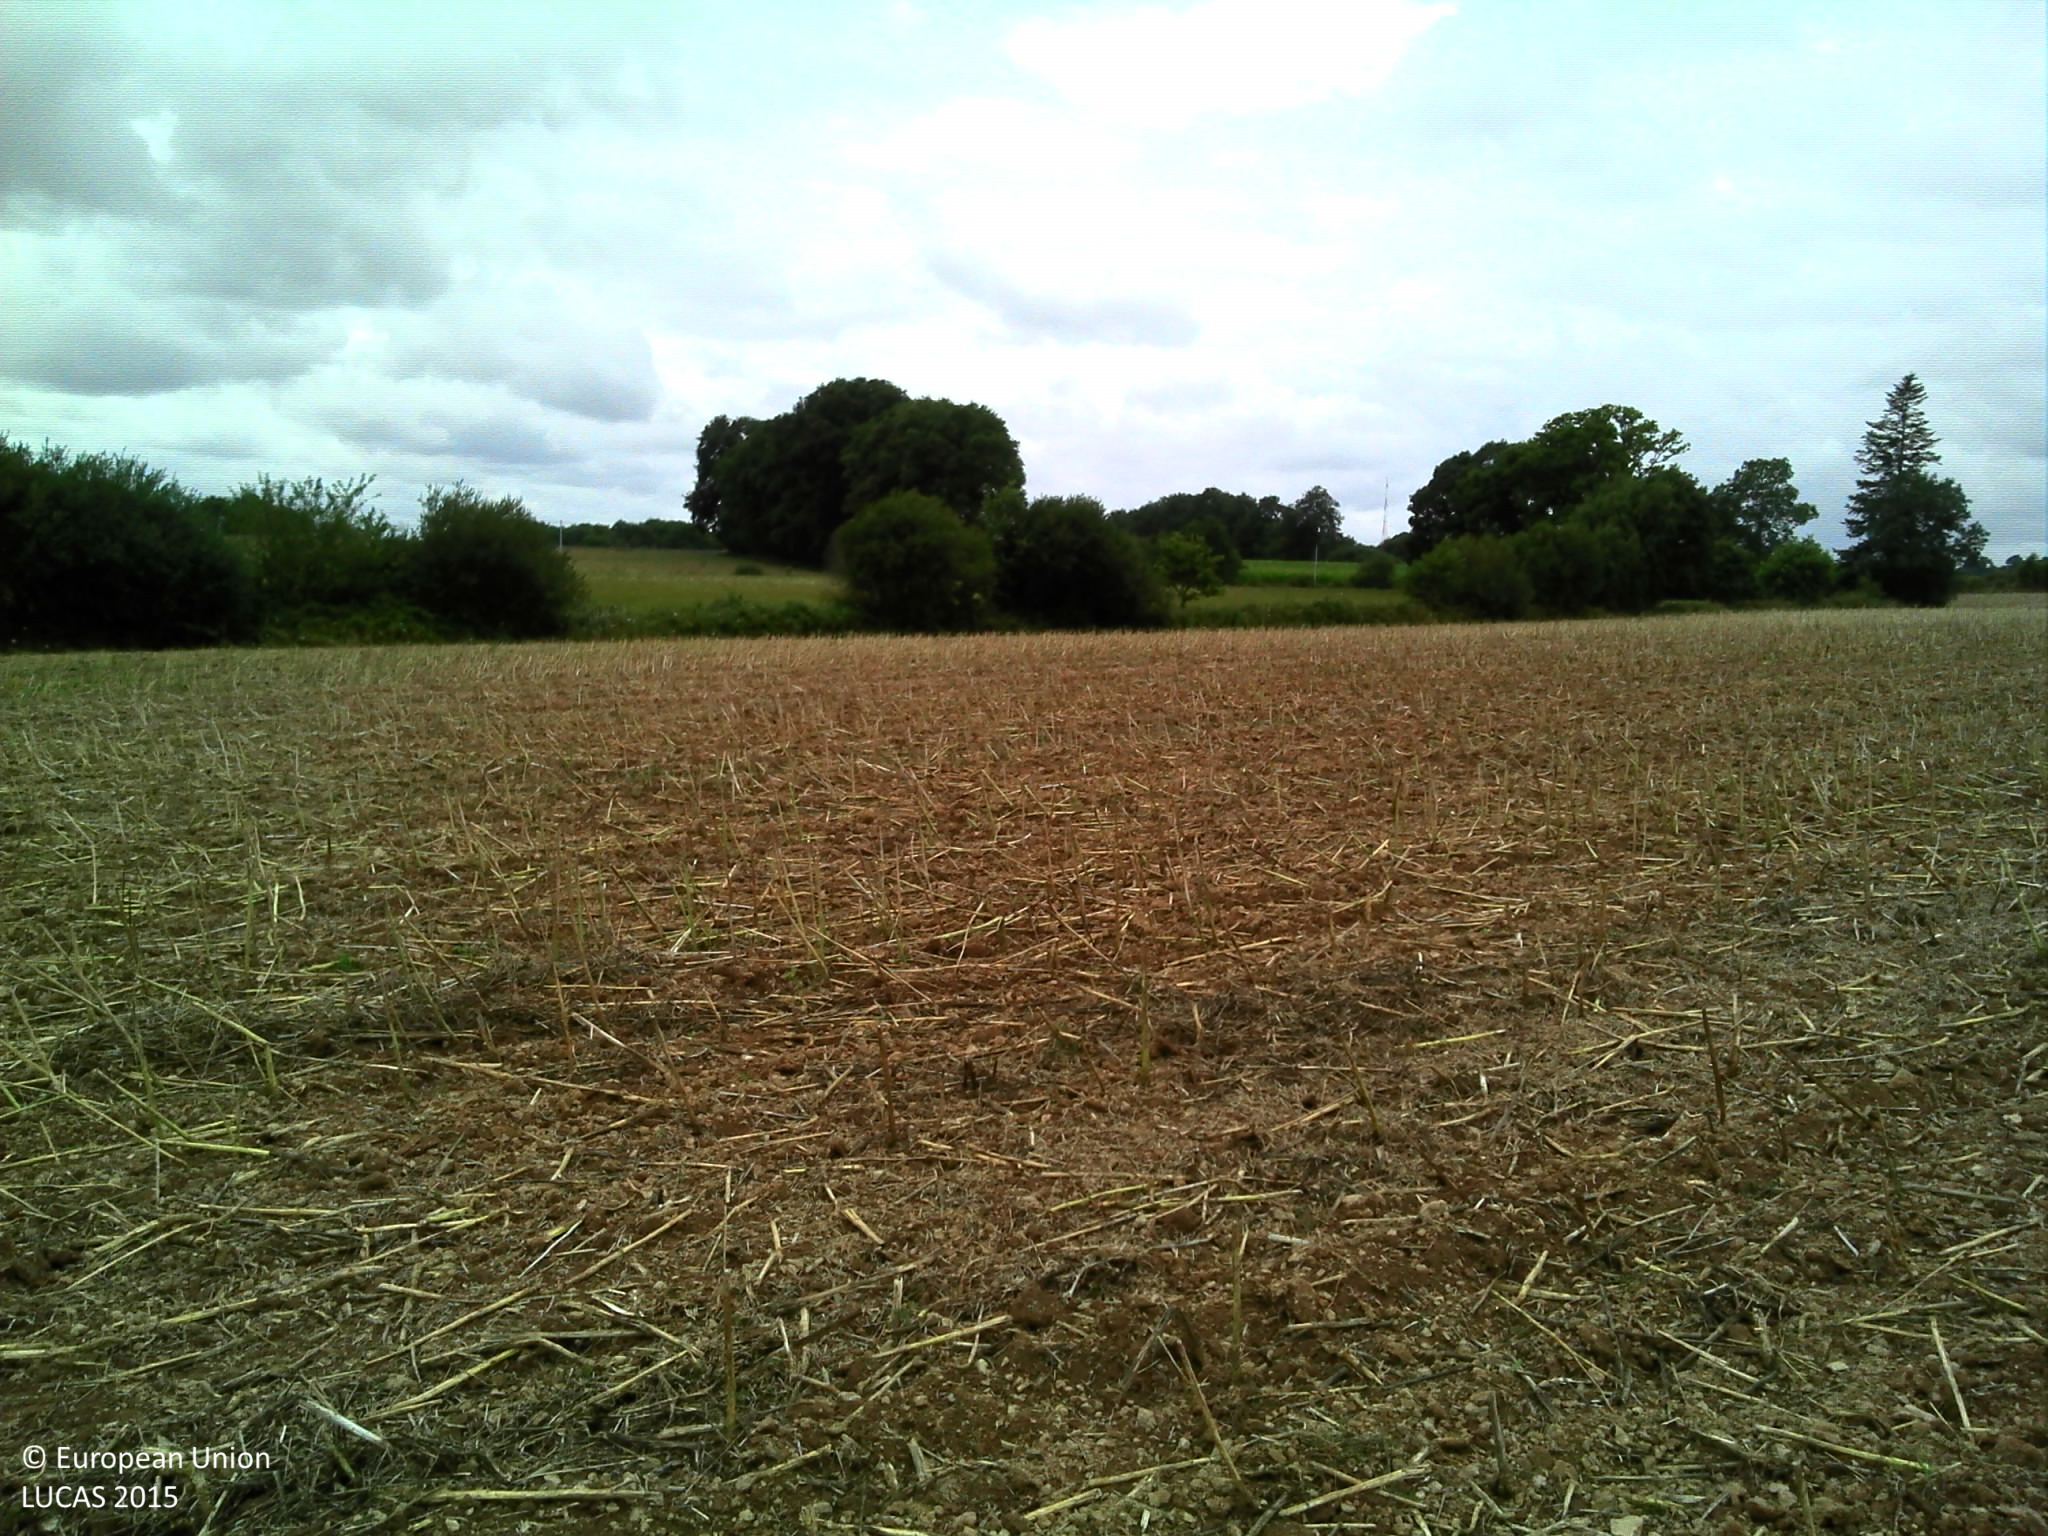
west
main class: Cropland
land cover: Rape and turnip rape
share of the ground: < 10 %
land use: Agriculture (excluding fallow land and kitchen gardens)
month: July
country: FR
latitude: 47.5122
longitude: -1.9866
